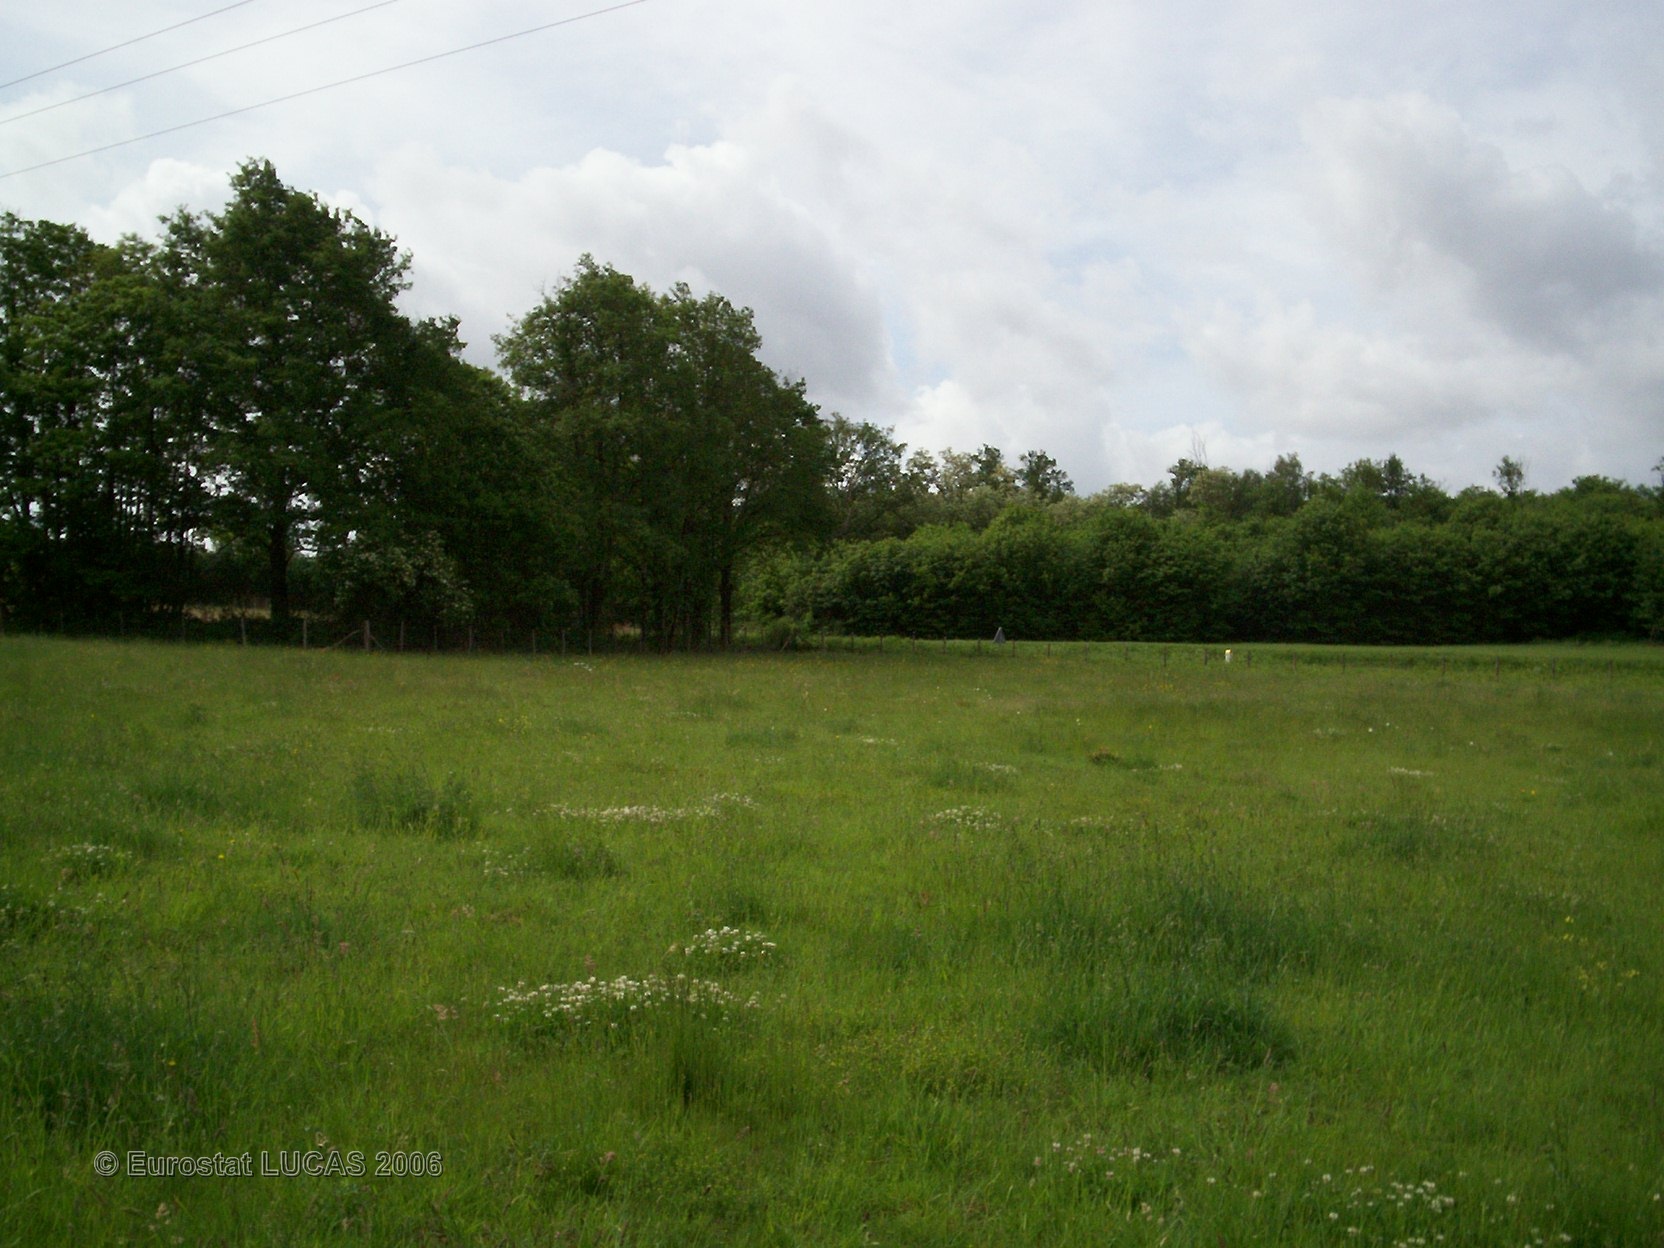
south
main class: Grassland
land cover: Grassland without tree/shrub cover
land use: Agriculture (excluding fallow land and kitchen gardens)
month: May
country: FR
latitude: 45.8746
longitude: 0.5161
